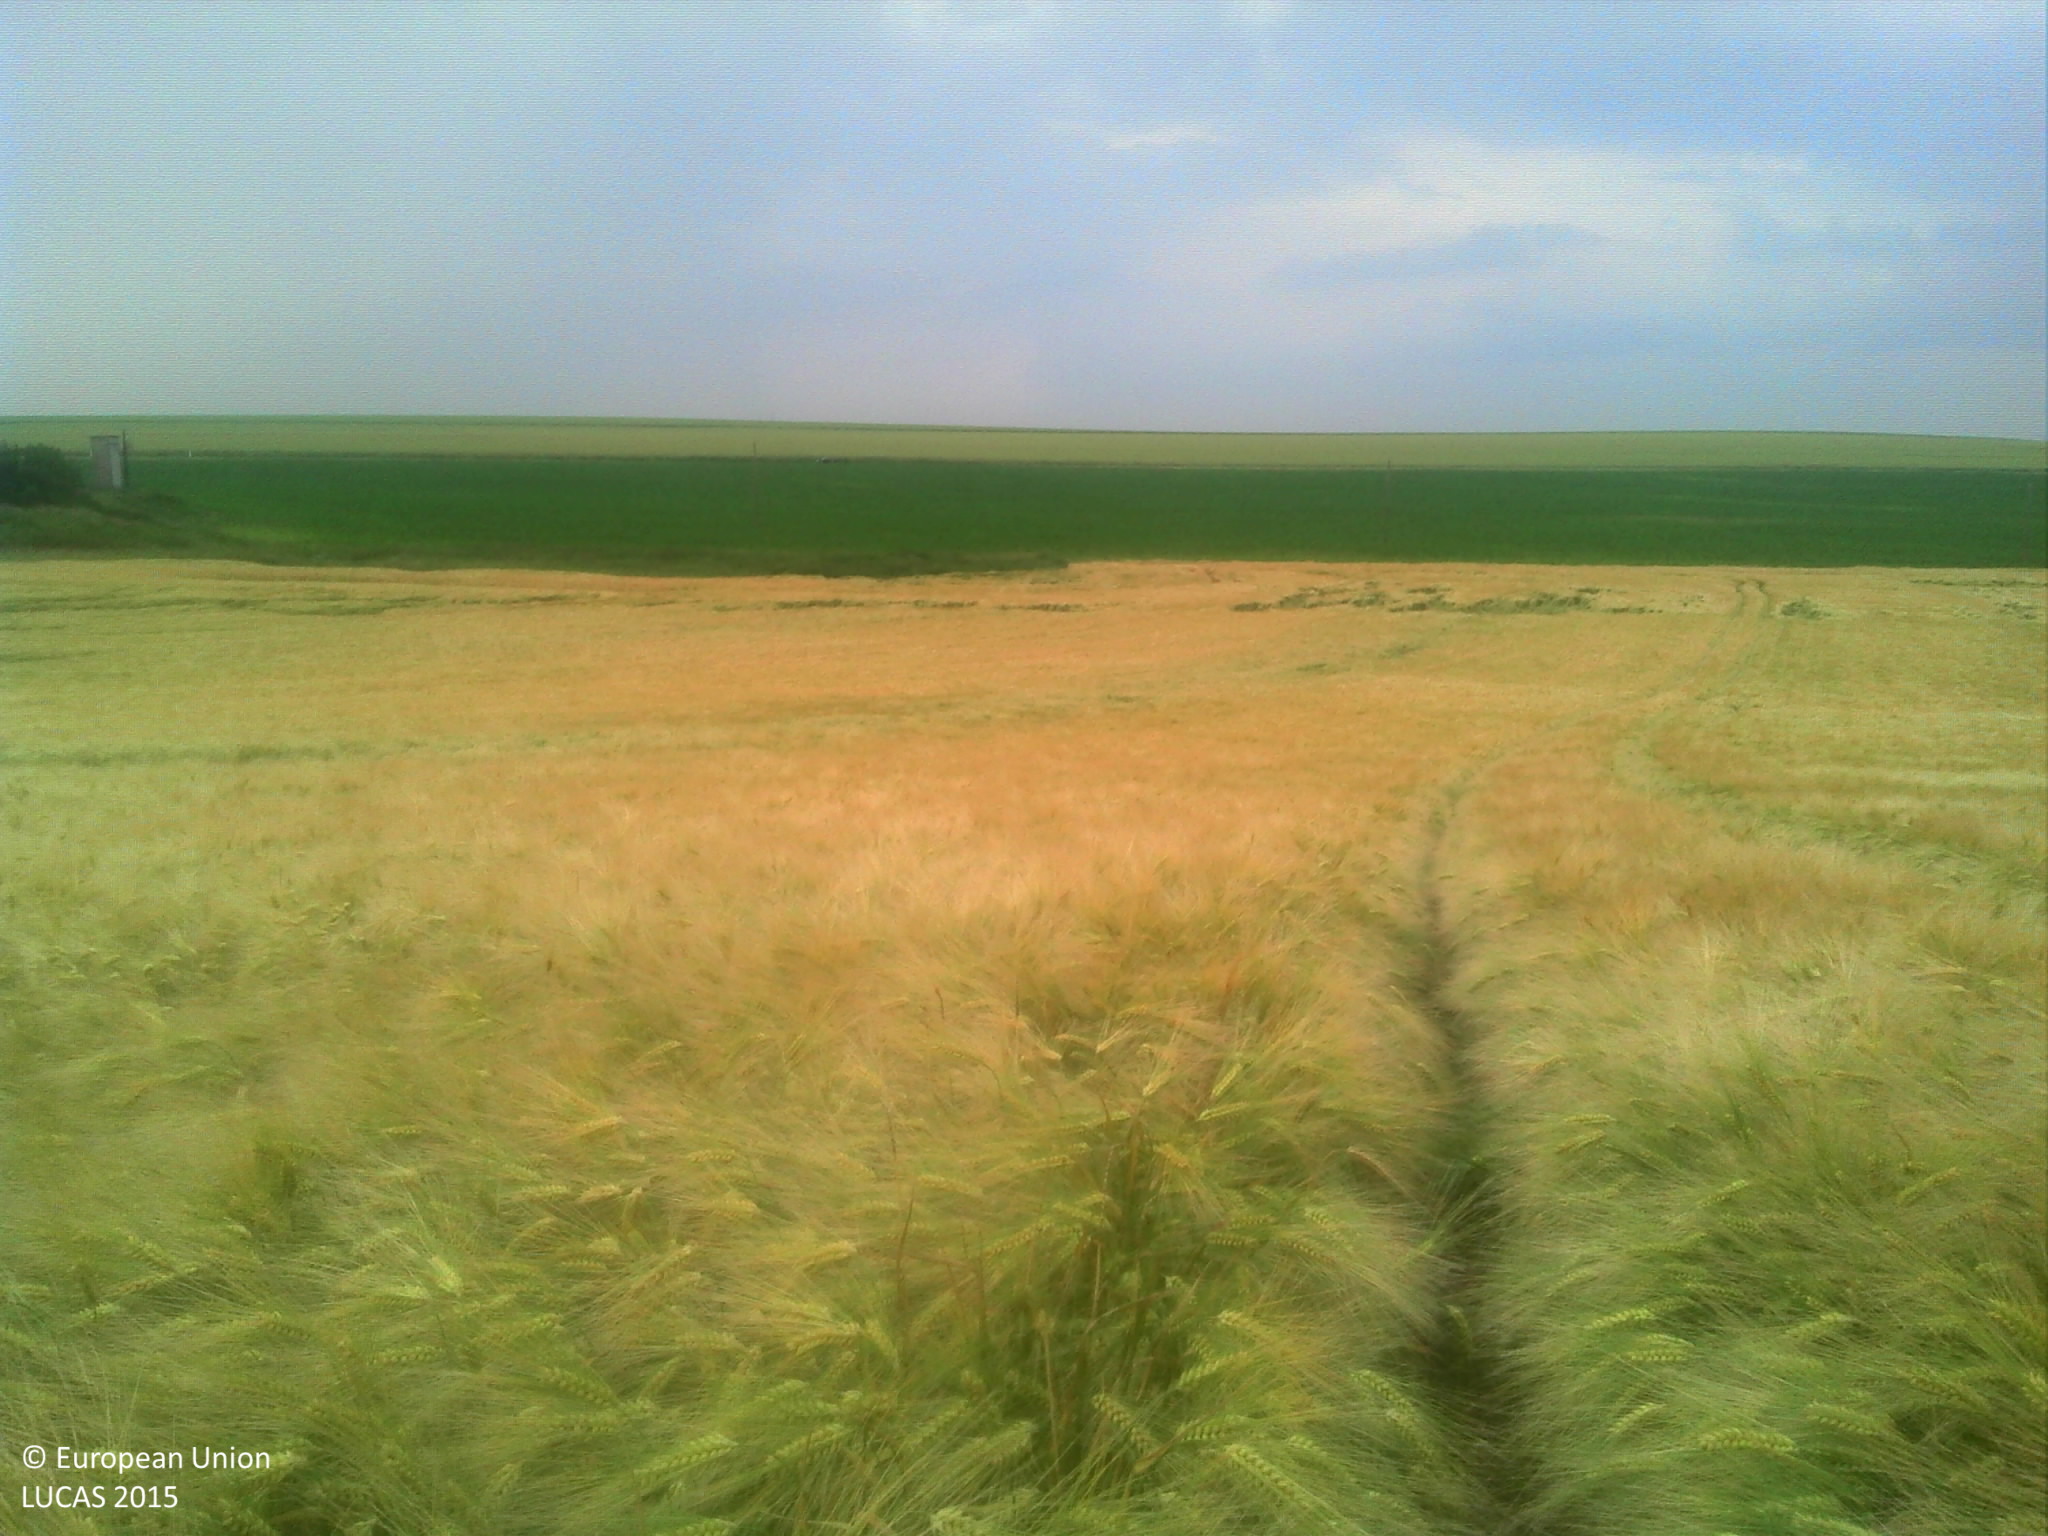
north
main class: Cropland
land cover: Barley
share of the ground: > 75 %
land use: Agriculture (excluding fallow land and kitchen gardens)
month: June
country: FR
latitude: 48.2316
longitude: 4.8962
